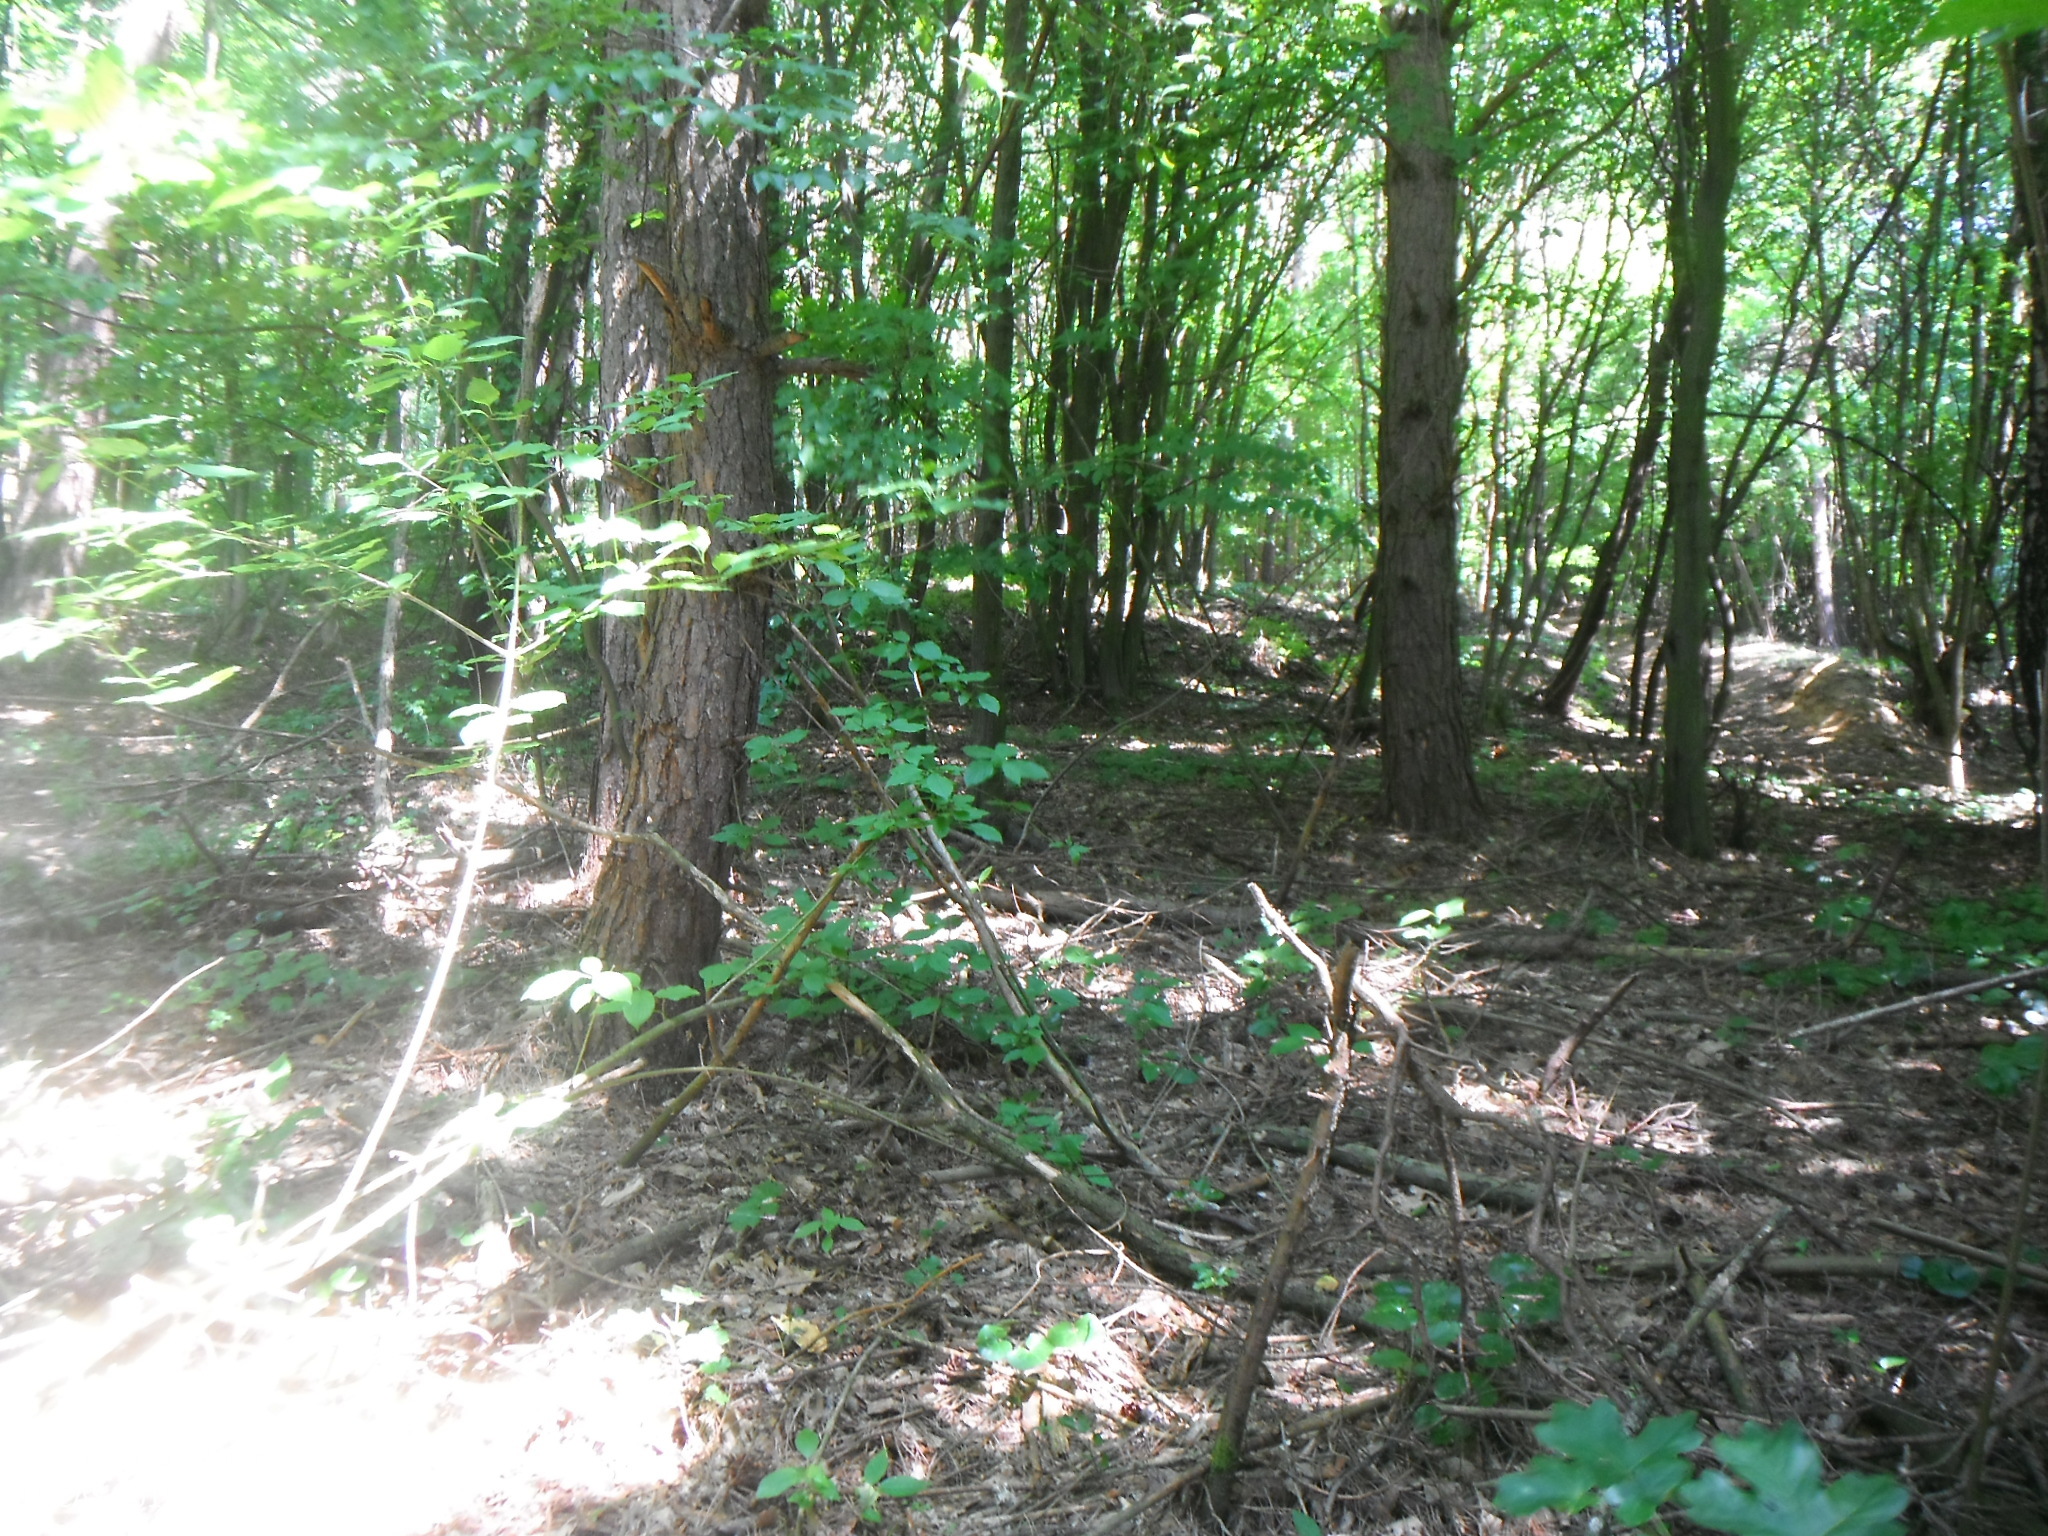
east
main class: Woodland
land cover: Pine dominated mixed woodland
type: beech forest
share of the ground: > 75 %
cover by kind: broadleaved forest trees 70 %, coniferous forest trees 30 %
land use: Forestry
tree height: > 5 m
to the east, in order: Pine dominated mixed woodland; Tracks; Pine dominated mixed woodland
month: June
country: SK
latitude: 49.0081
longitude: 21.6019
